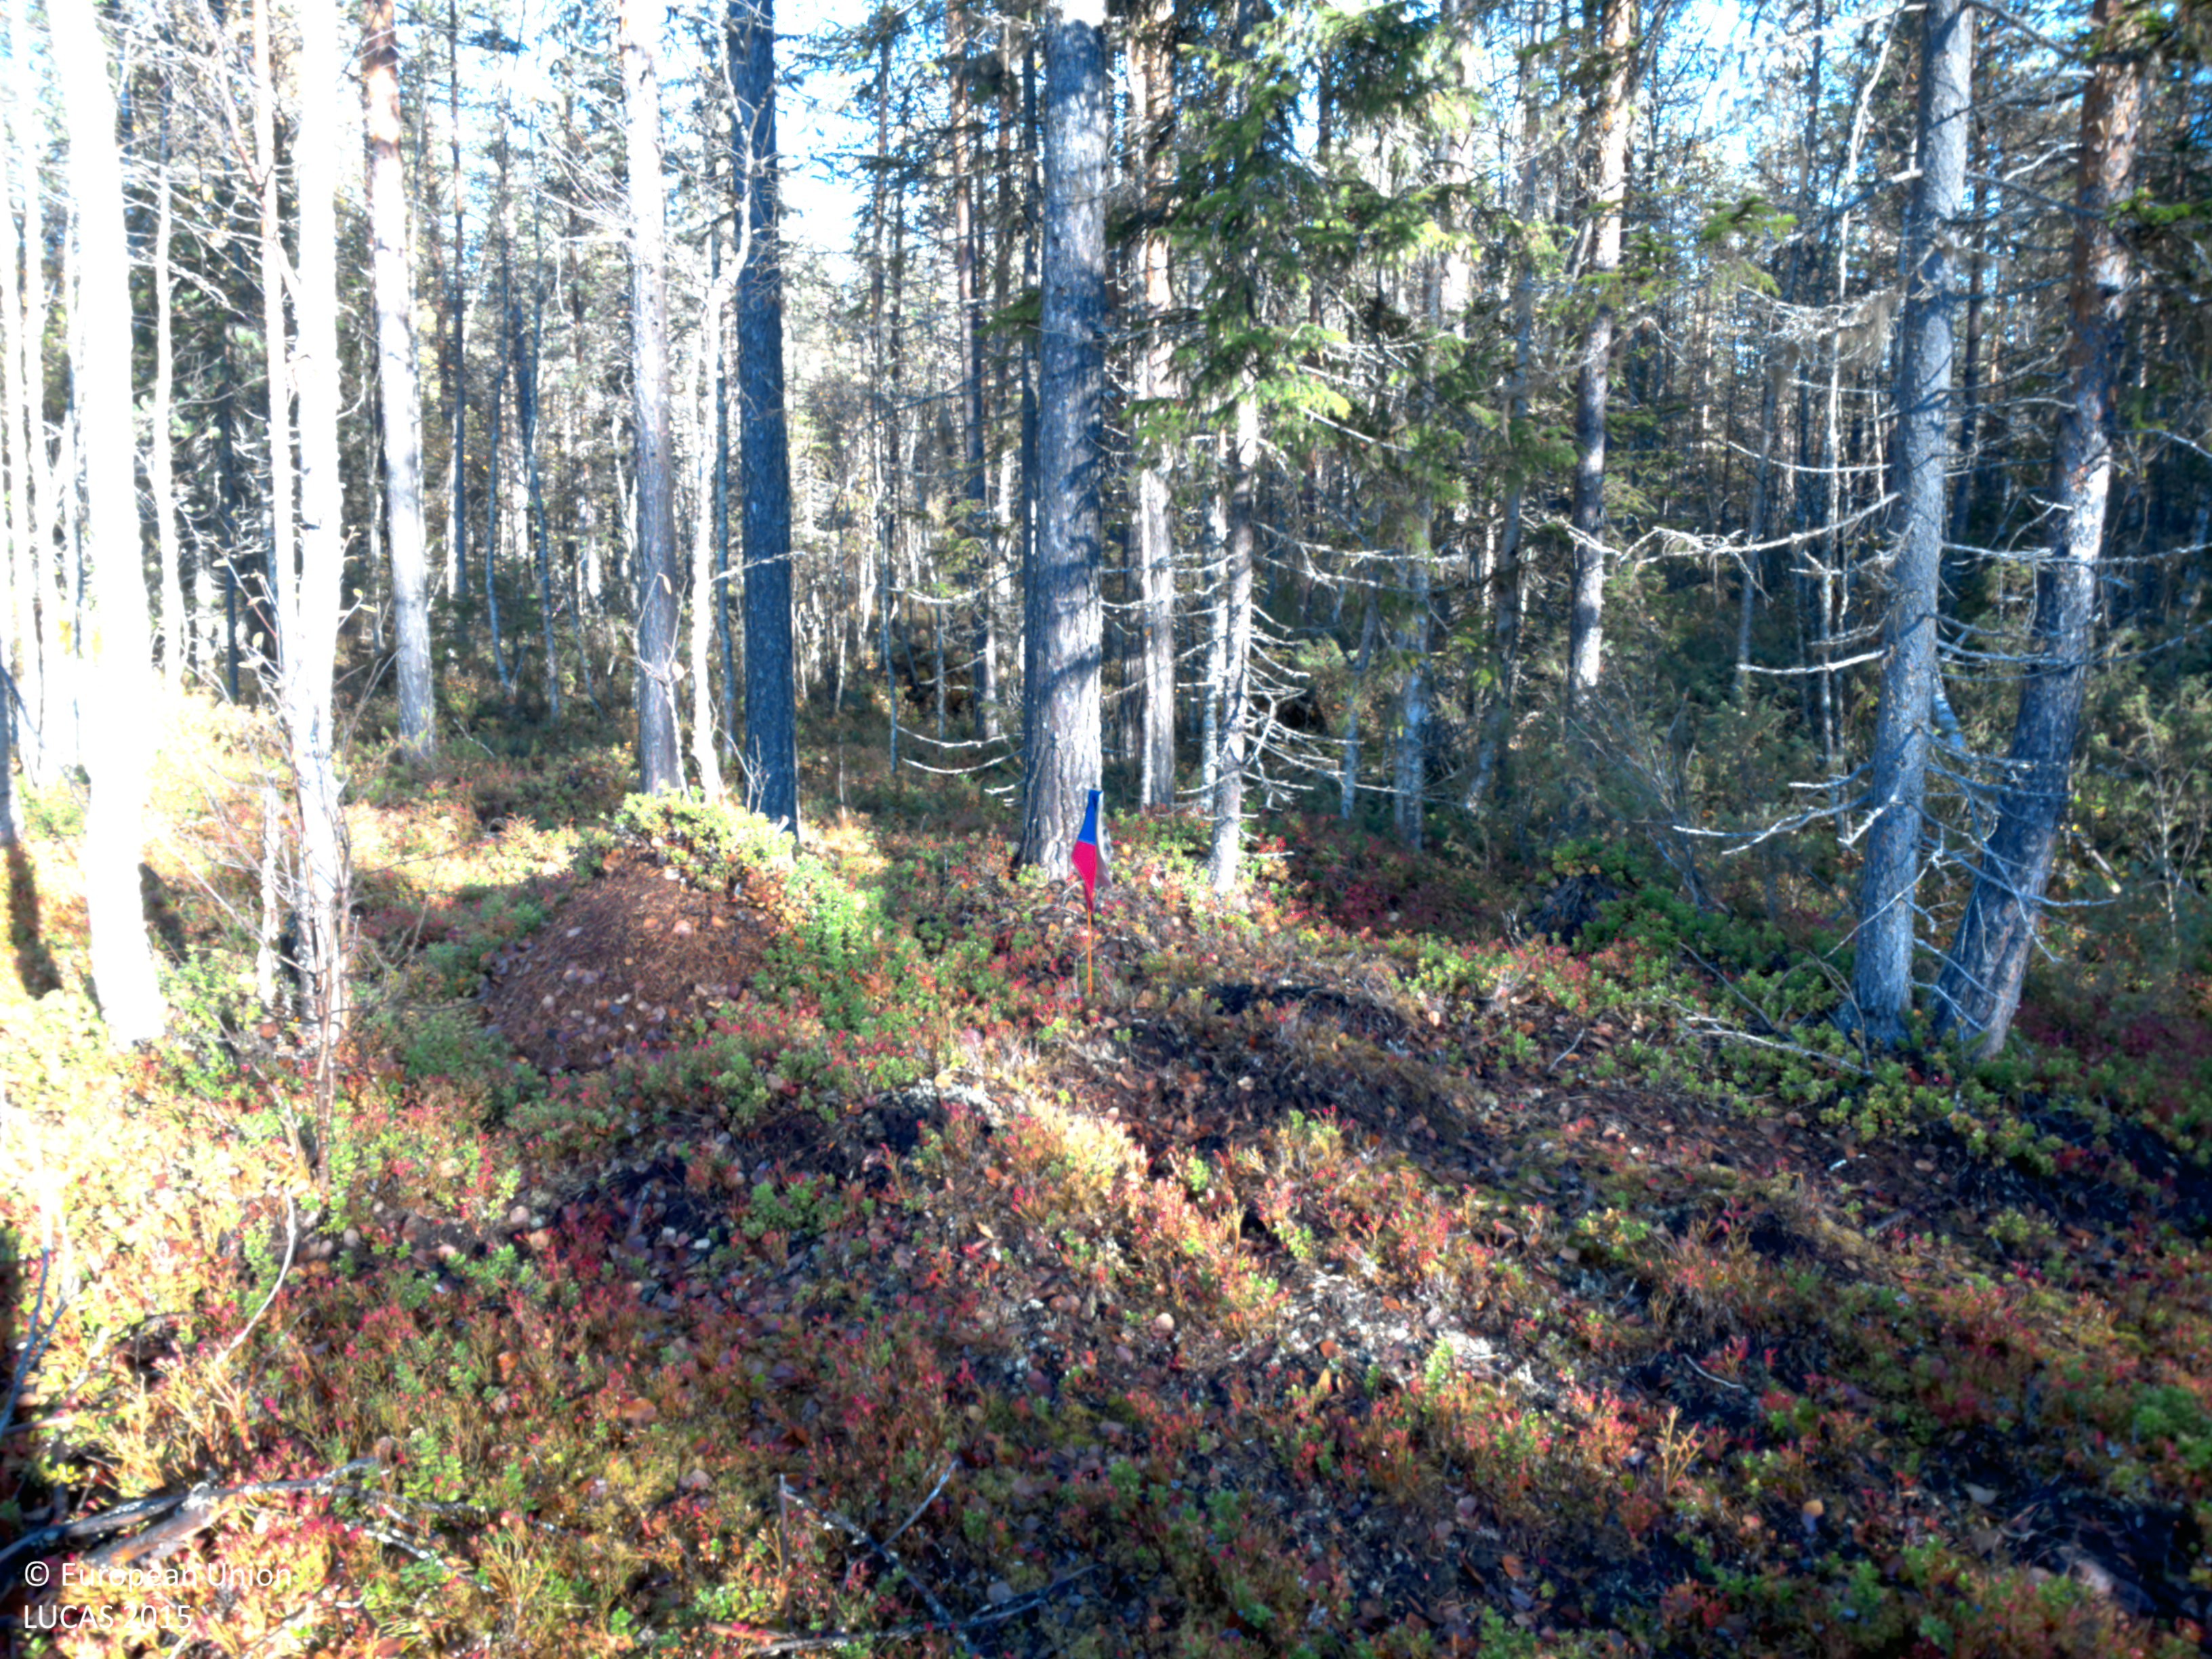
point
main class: Woodland
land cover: Pine dominated mixed woodland
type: boreal forest
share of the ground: > 75 %
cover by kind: coniferous forest trees 60 %, broadleaved forest trees 20 %, shrubs 15 %, lichens and mosses 5 %
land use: Forestry
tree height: > 5 m
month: September
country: SE
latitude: 64.8156
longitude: 19.0024
